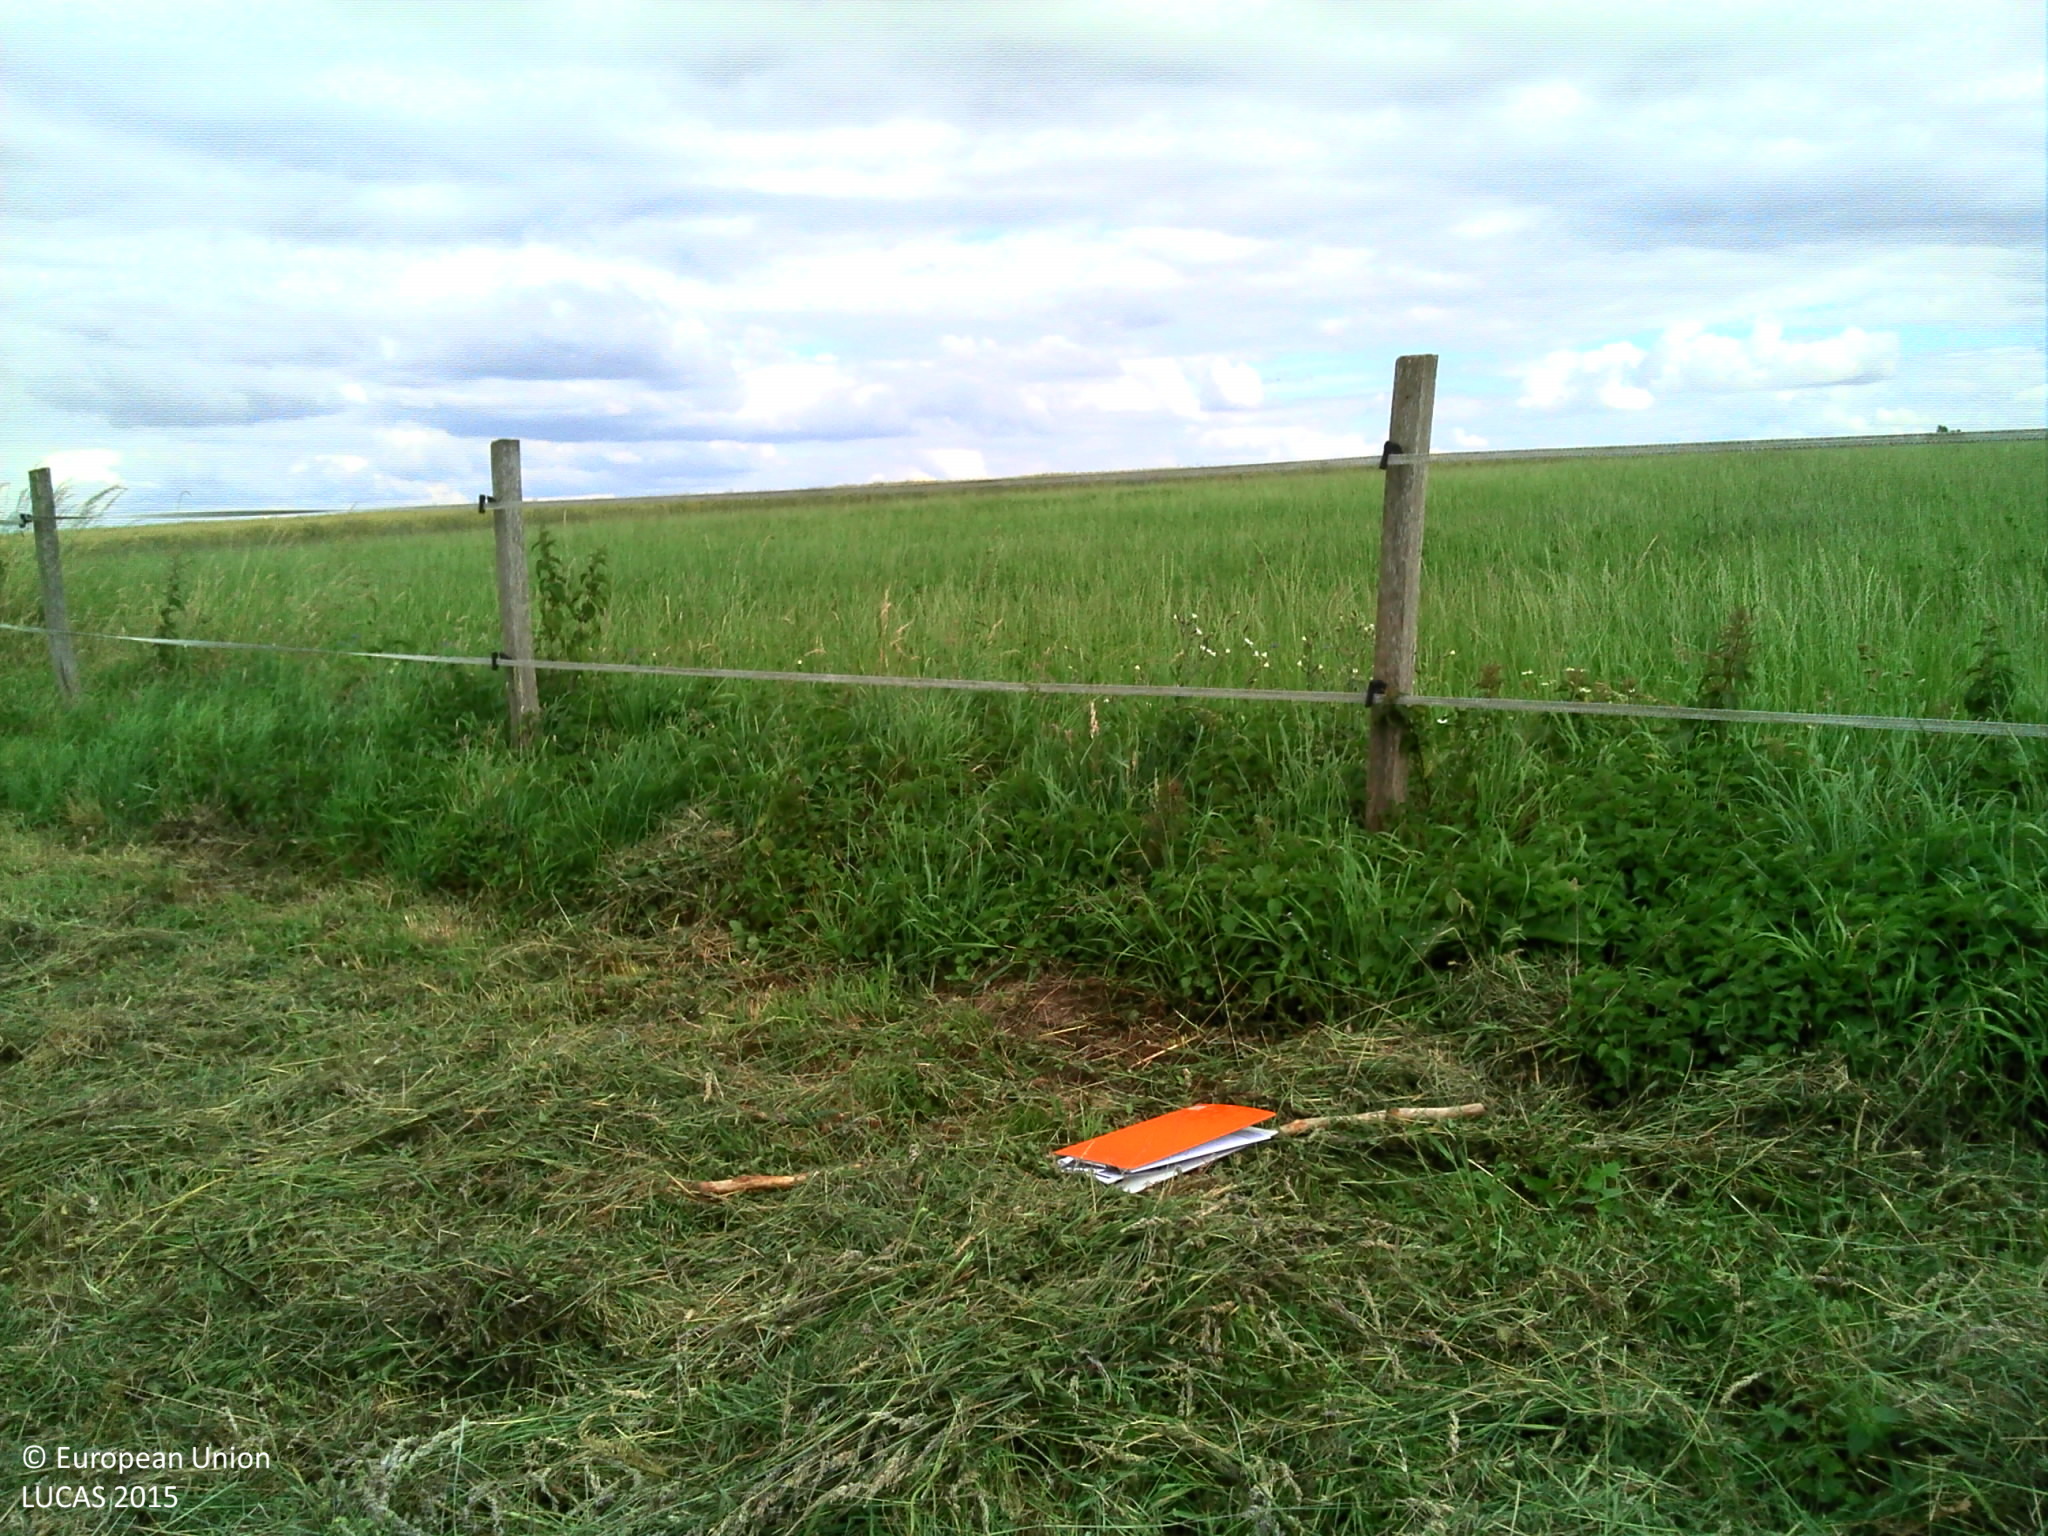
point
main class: Grassland
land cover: Grassland without tree/shrub cover
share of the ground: > 75 %
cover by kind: herbaceous plants 100 %
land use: Agriculture (excluding fallow land and kitchen gardens)
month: June
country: FR
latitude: 46.1395
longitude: 2.9950
